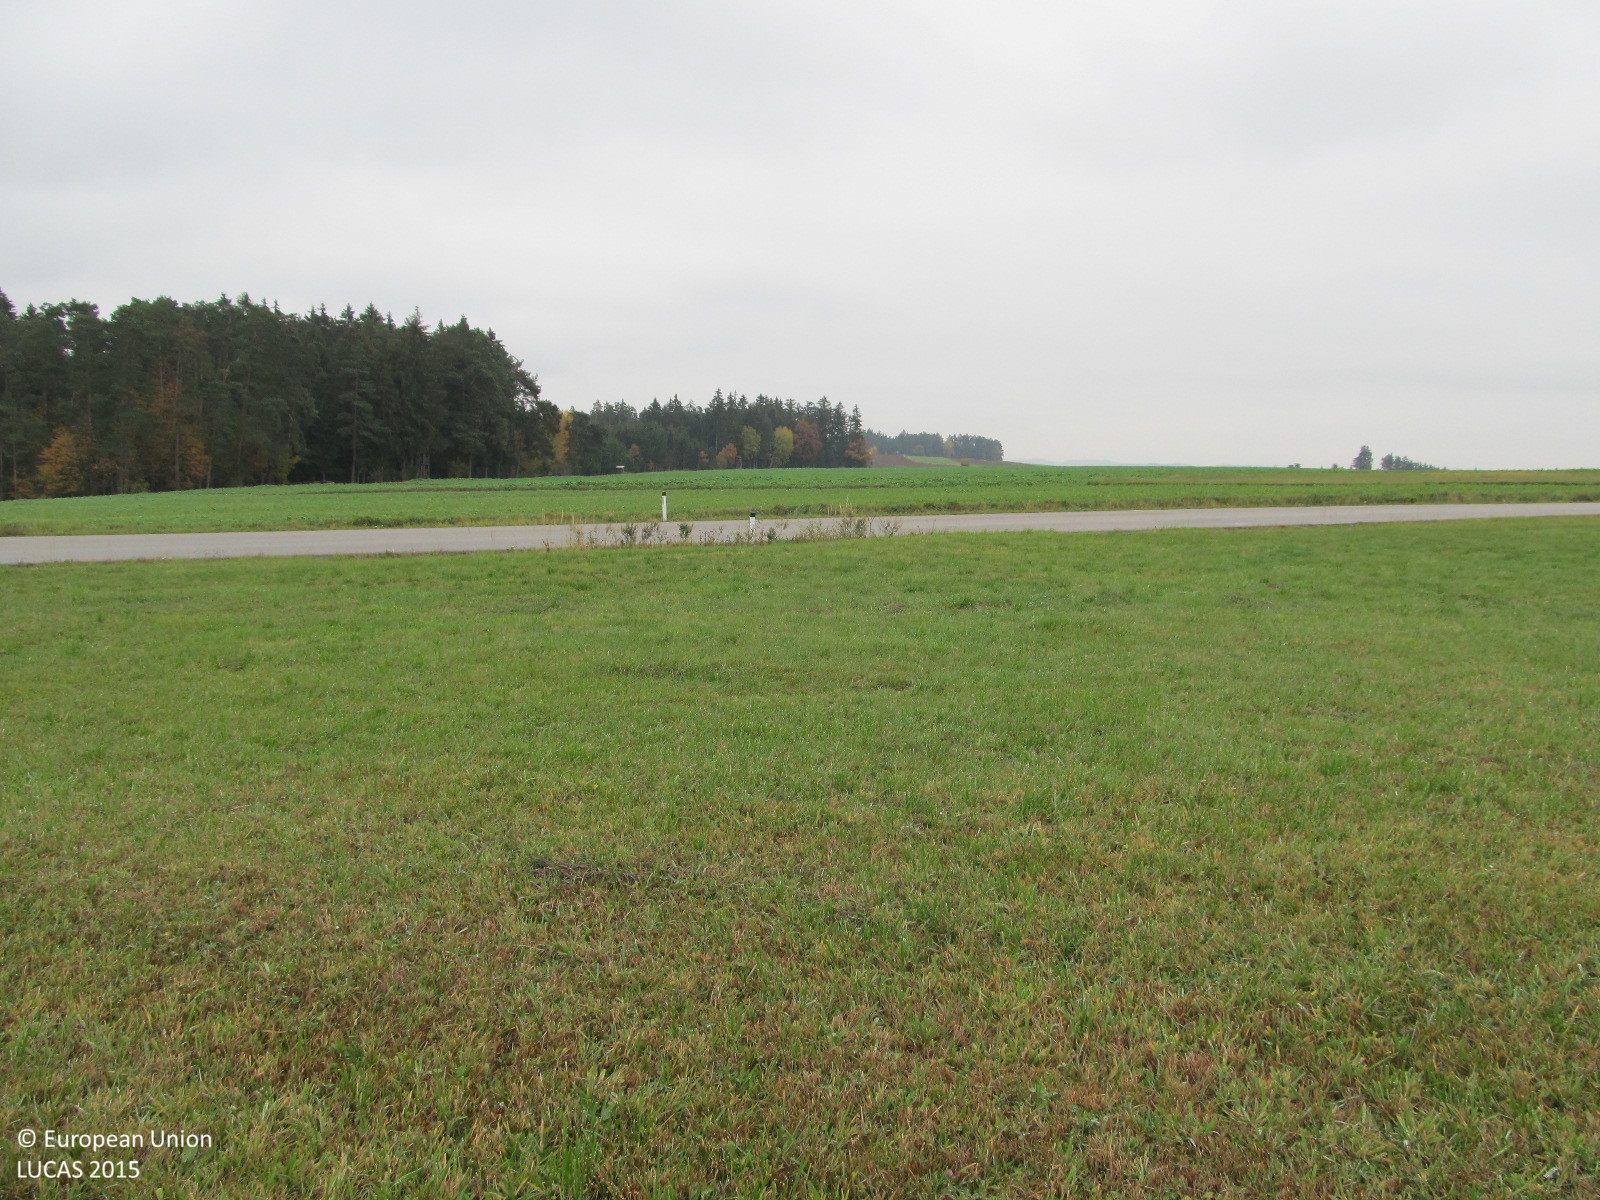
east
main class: Grassland
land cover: Grassland without tree/shrub cover
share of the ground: > 75 %
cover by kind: herbaceous plants 100 %
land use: Agriculture (excluding fallow land and kitchen gardens)
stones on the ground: < 10 %
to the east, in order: Grassland without tree/shrub cover; Ditches and canals; Grass margins; Paved roads, cycling and walking lanes; Grass margins; Ditches and canals; Other bare soil; Grass margins; Other bare soil; Other fibre and oleaginous crops
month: October
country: AT
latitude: 48.6135
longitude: 15.4147
